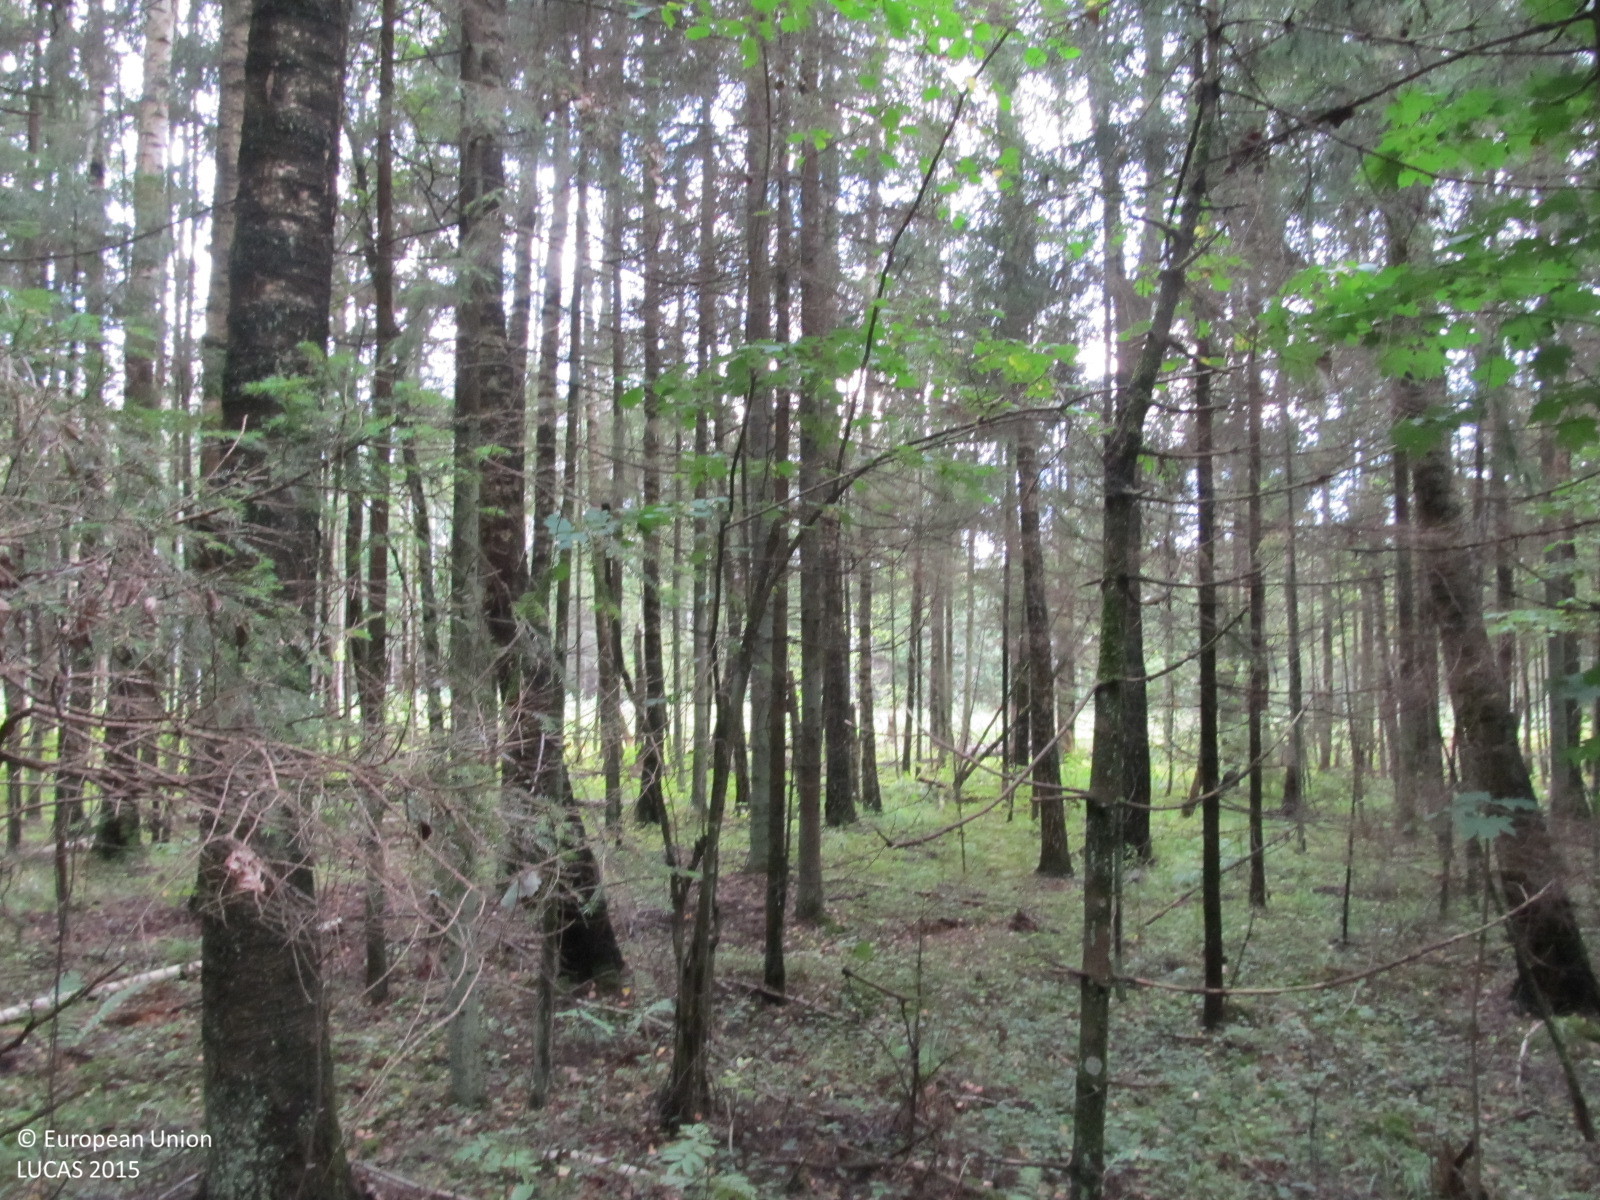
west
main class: Woodland
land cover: Spruce dominated mixed woodland
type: non-riverine alder, birch or aspen forest
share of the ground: > 75 %
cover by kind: coniferous forest trees 50 %, broadleaved forest trees 30 %, herbaceous plants 10 %, lichens and mosses 5 %, unconsolidated bare surface 5 %
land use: Forestry
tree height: > 5 m
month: September
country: LT
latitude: 55.9979
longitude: 22.8115
